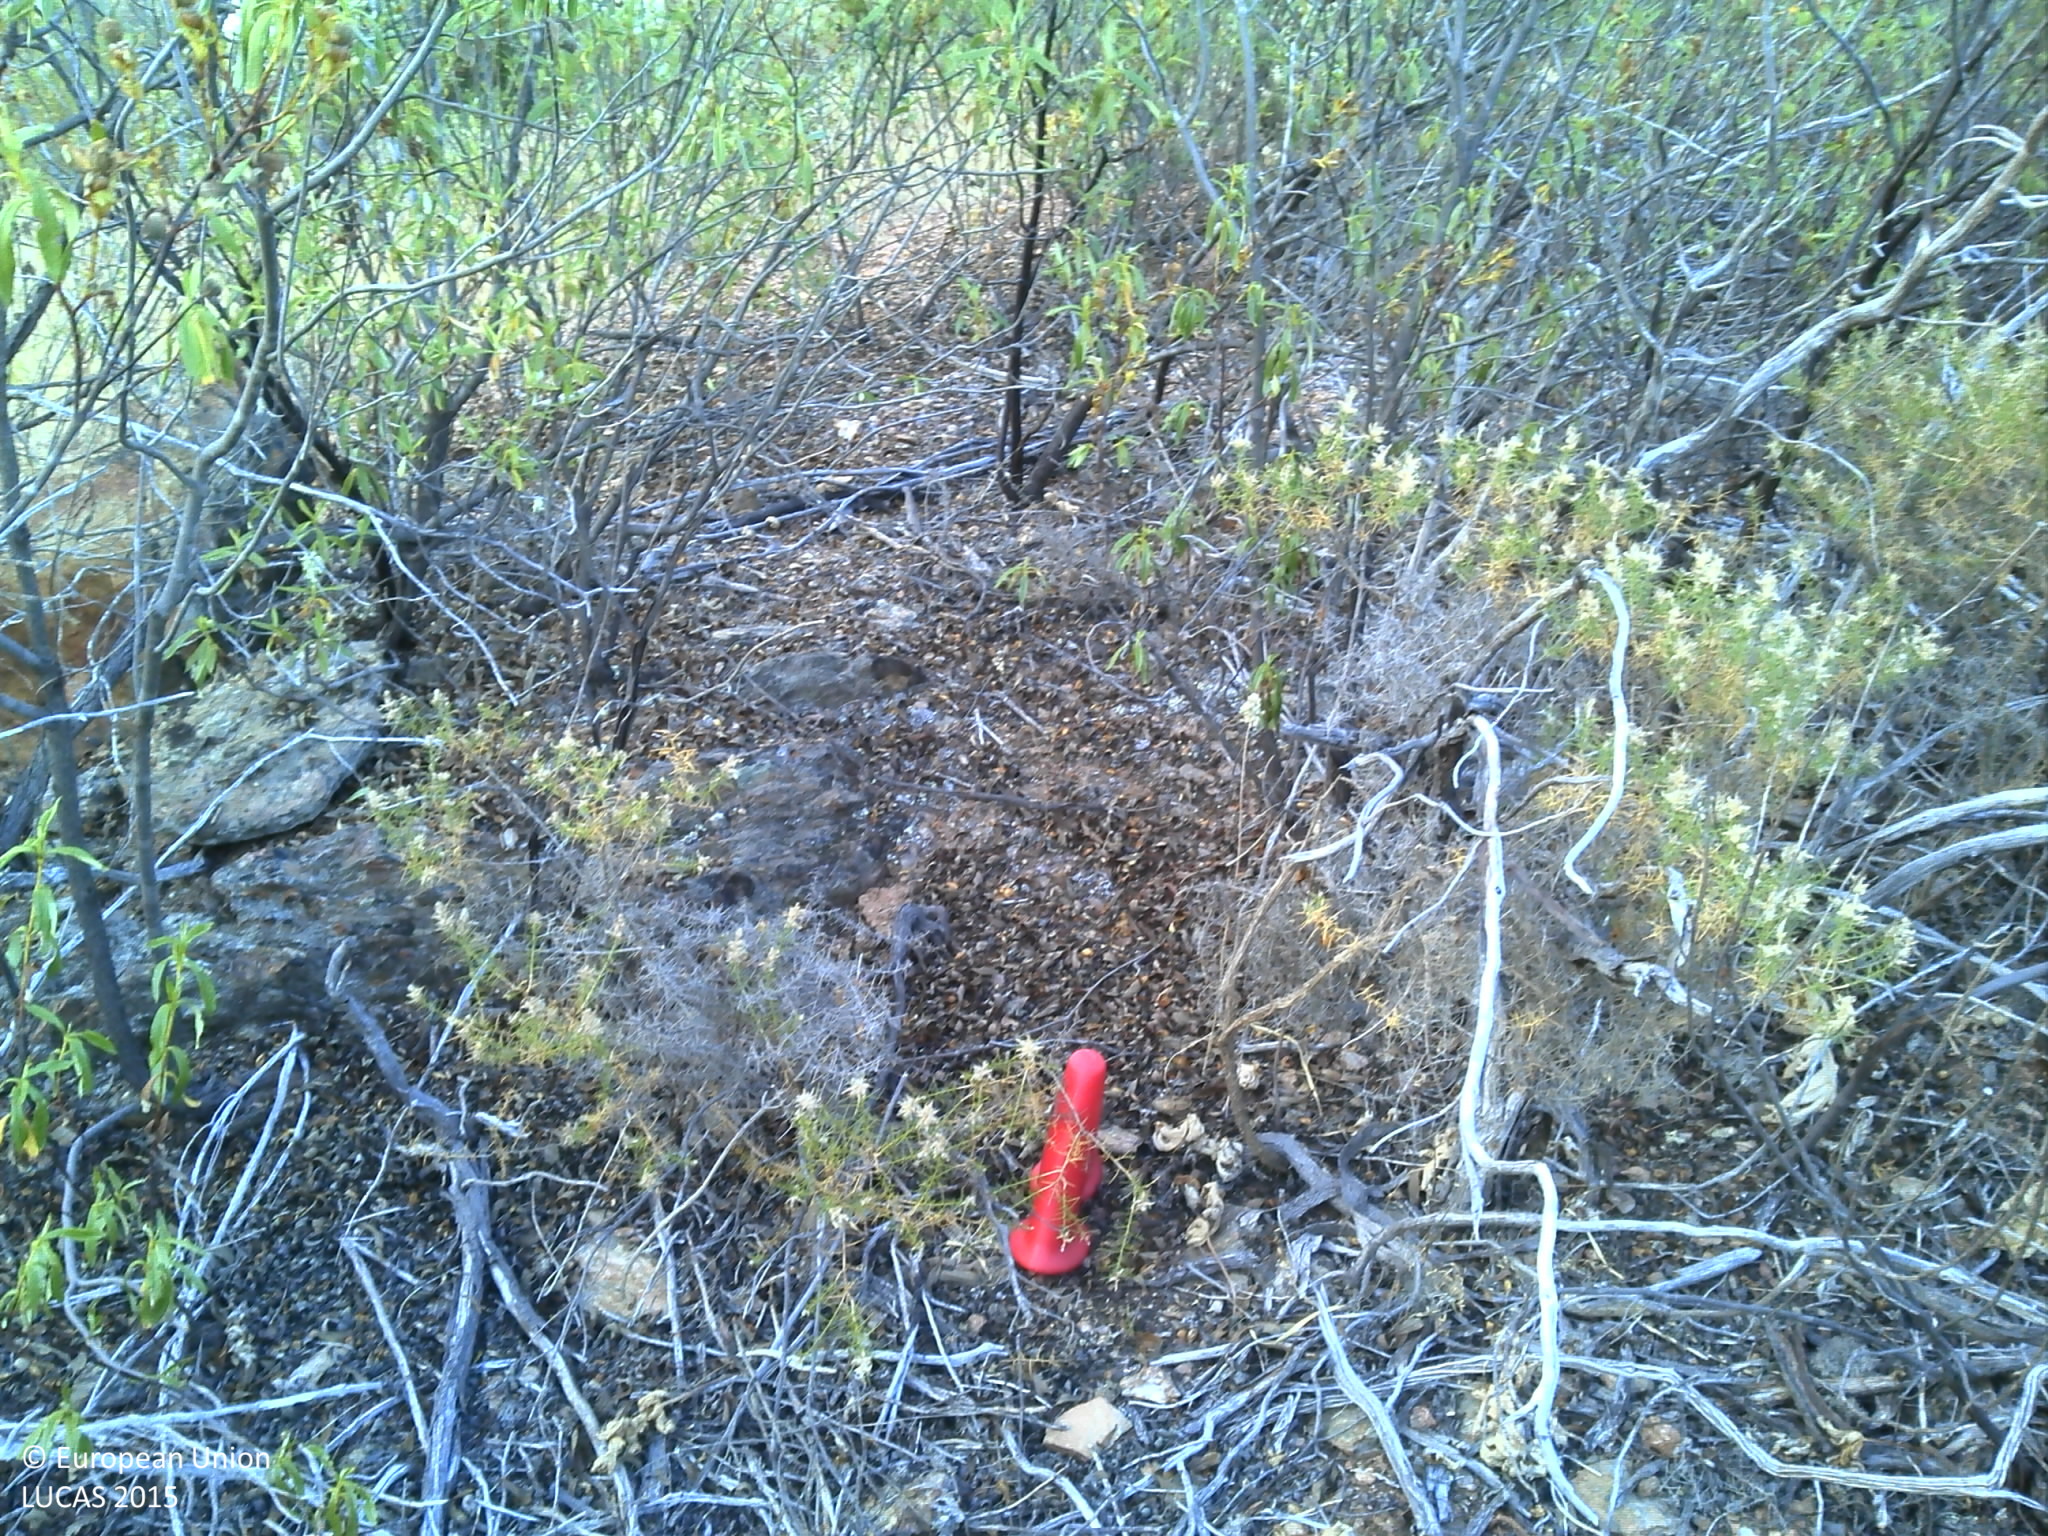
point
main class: Shrubland
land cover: Shrubland without tree cover
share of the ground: > 75 %
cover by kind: shrubs 90 %, unconsolidated bare surface 10 %
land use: Semi-natural and natural areas not in use
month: June
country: PT
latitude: 37.7880
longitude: -7.6299
